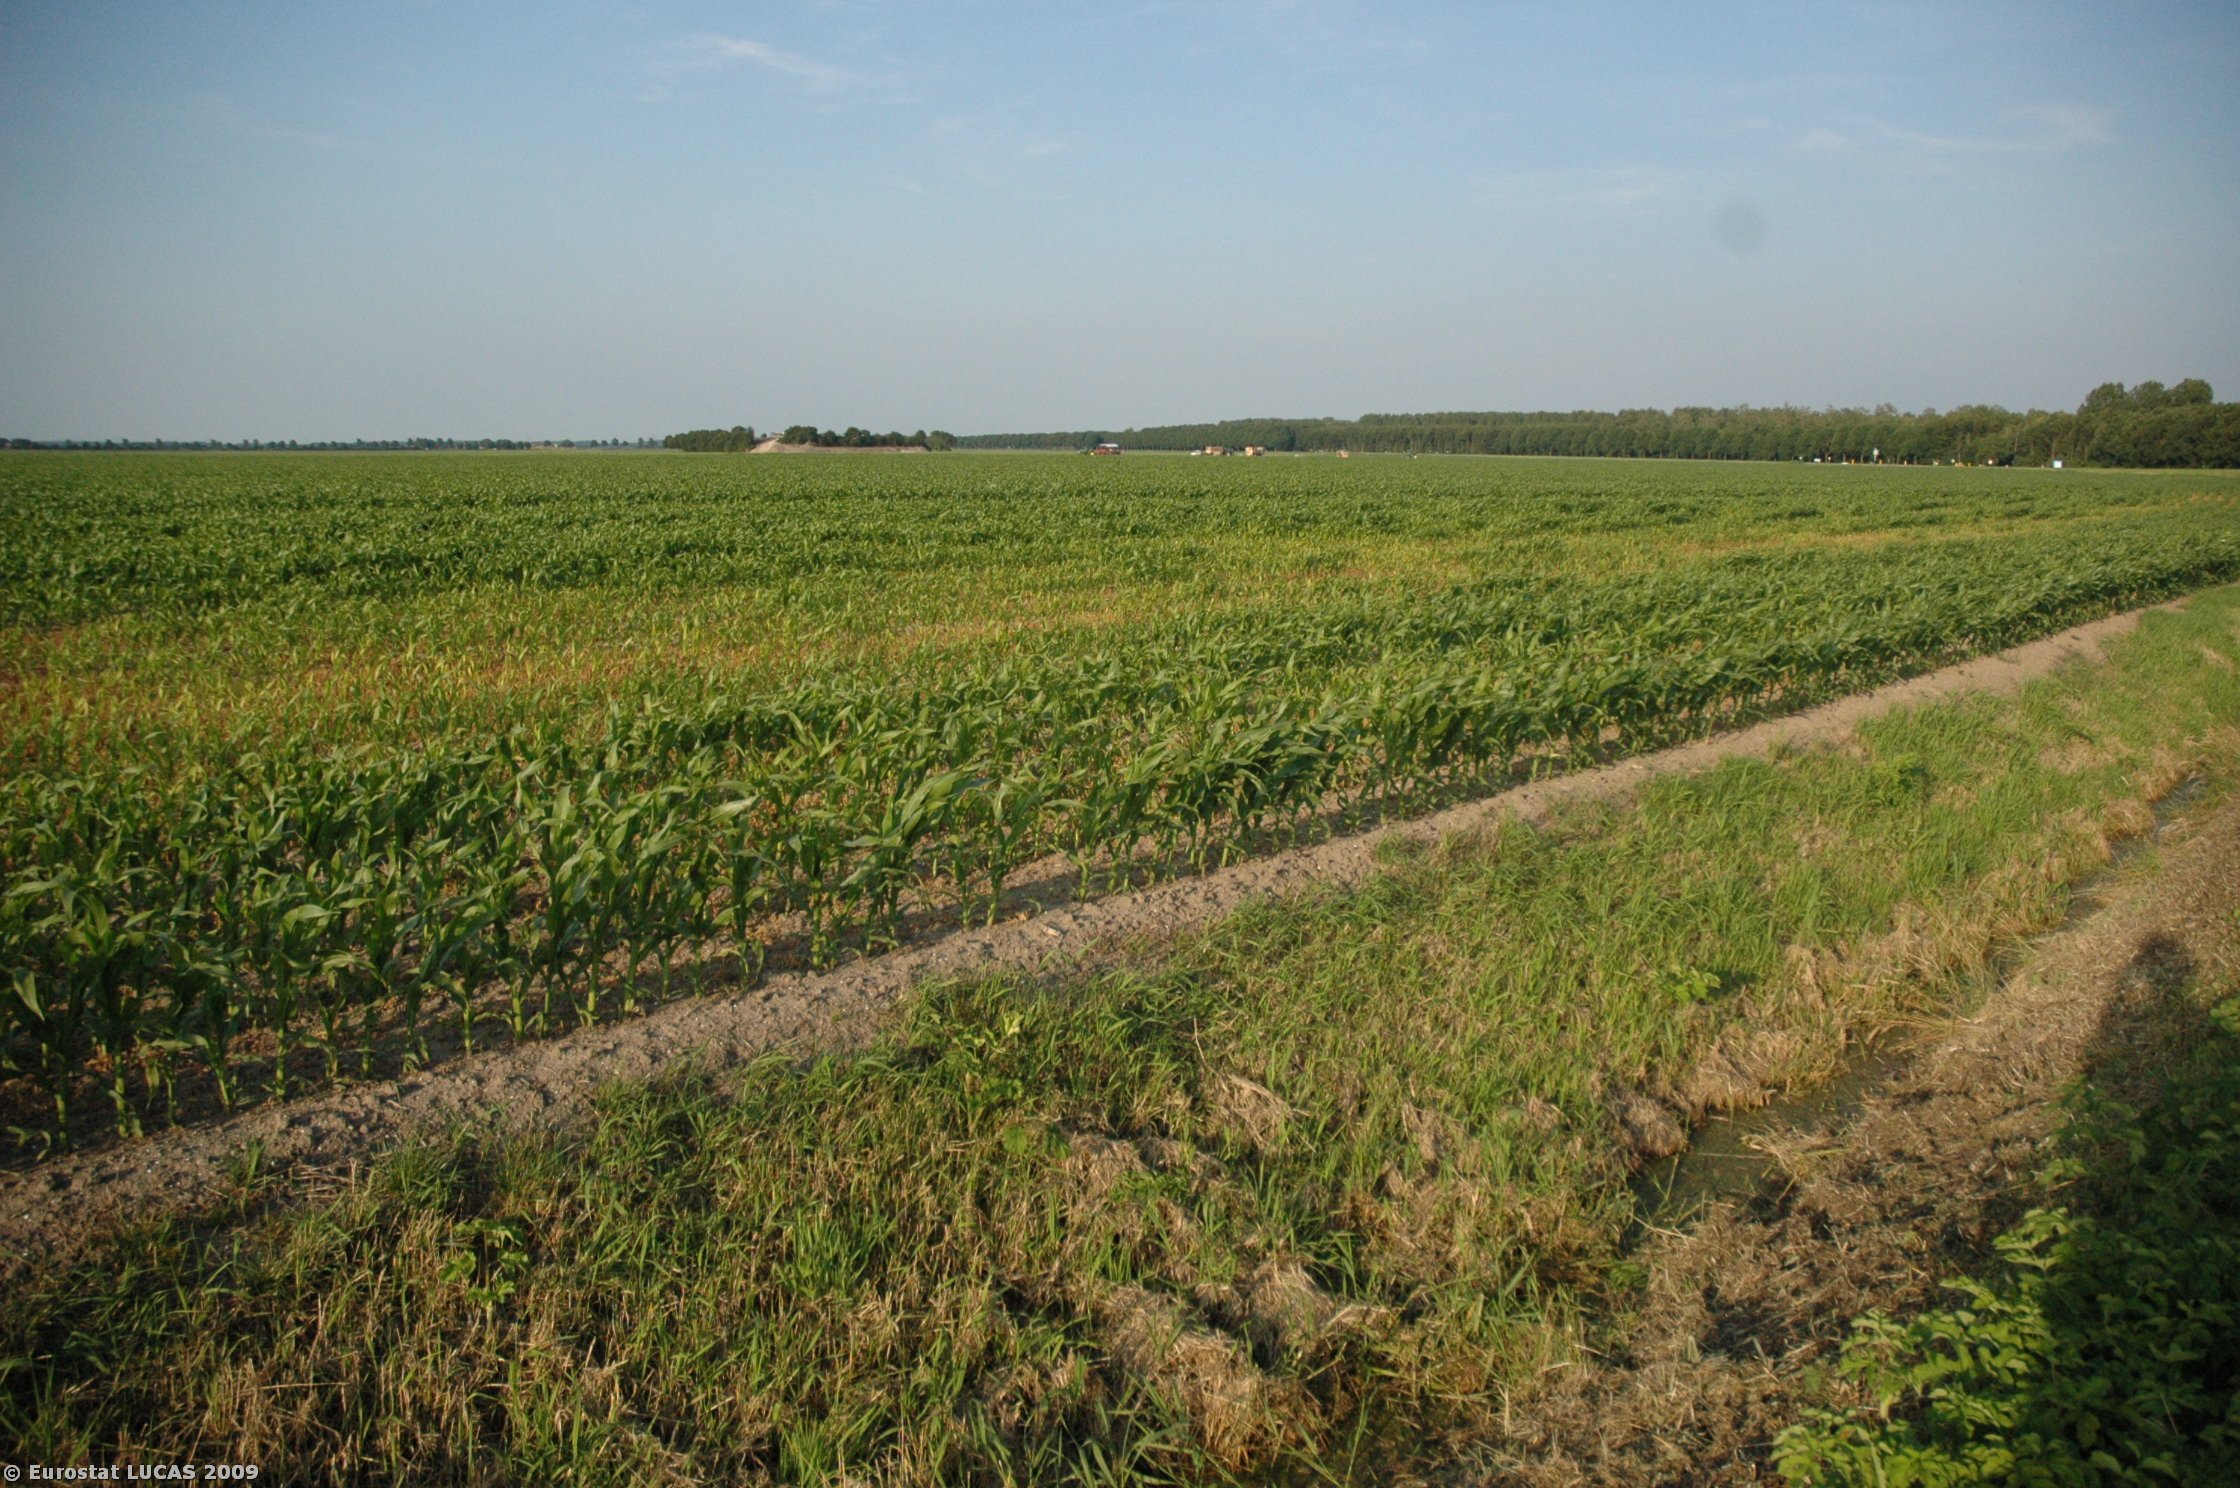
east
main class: Cropland
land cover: Maize
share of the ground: > 75 %
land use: Agriculture (excluding fallow land and kitchen gardens)
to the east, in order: Maize; Potatoes
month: June
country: NL
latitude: 52.2697
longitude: 5.3821
